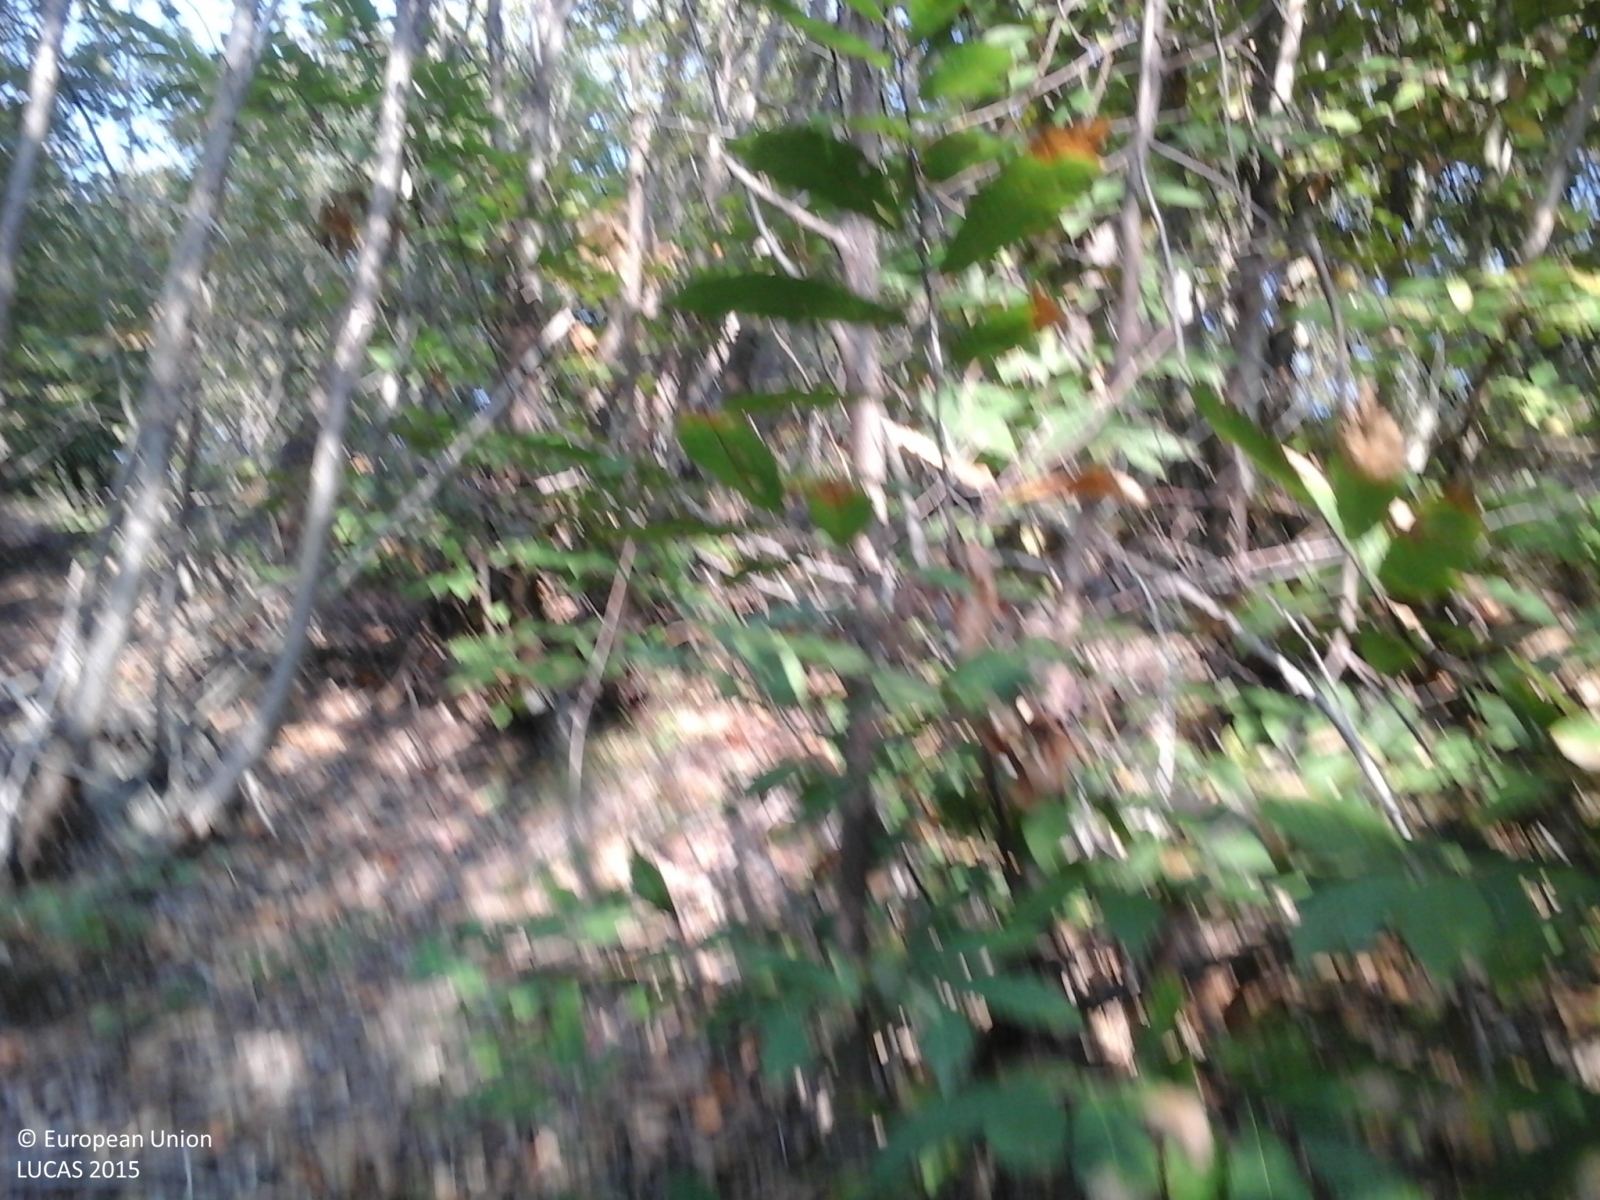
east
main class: Woodland
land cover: Broadleaved woodland
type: thermophilous deciduous forest
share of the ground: > 75 %
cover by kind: broadleaved forest trees 90 %, herbaceous plants 10 %
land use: Forestry
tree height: > 5 m
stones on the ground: 10 - 25 %
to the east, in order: Broadleaved woodland; Pine dominated mixed woodland
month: September
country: IT
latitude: 44.3360
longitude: 8.2606
